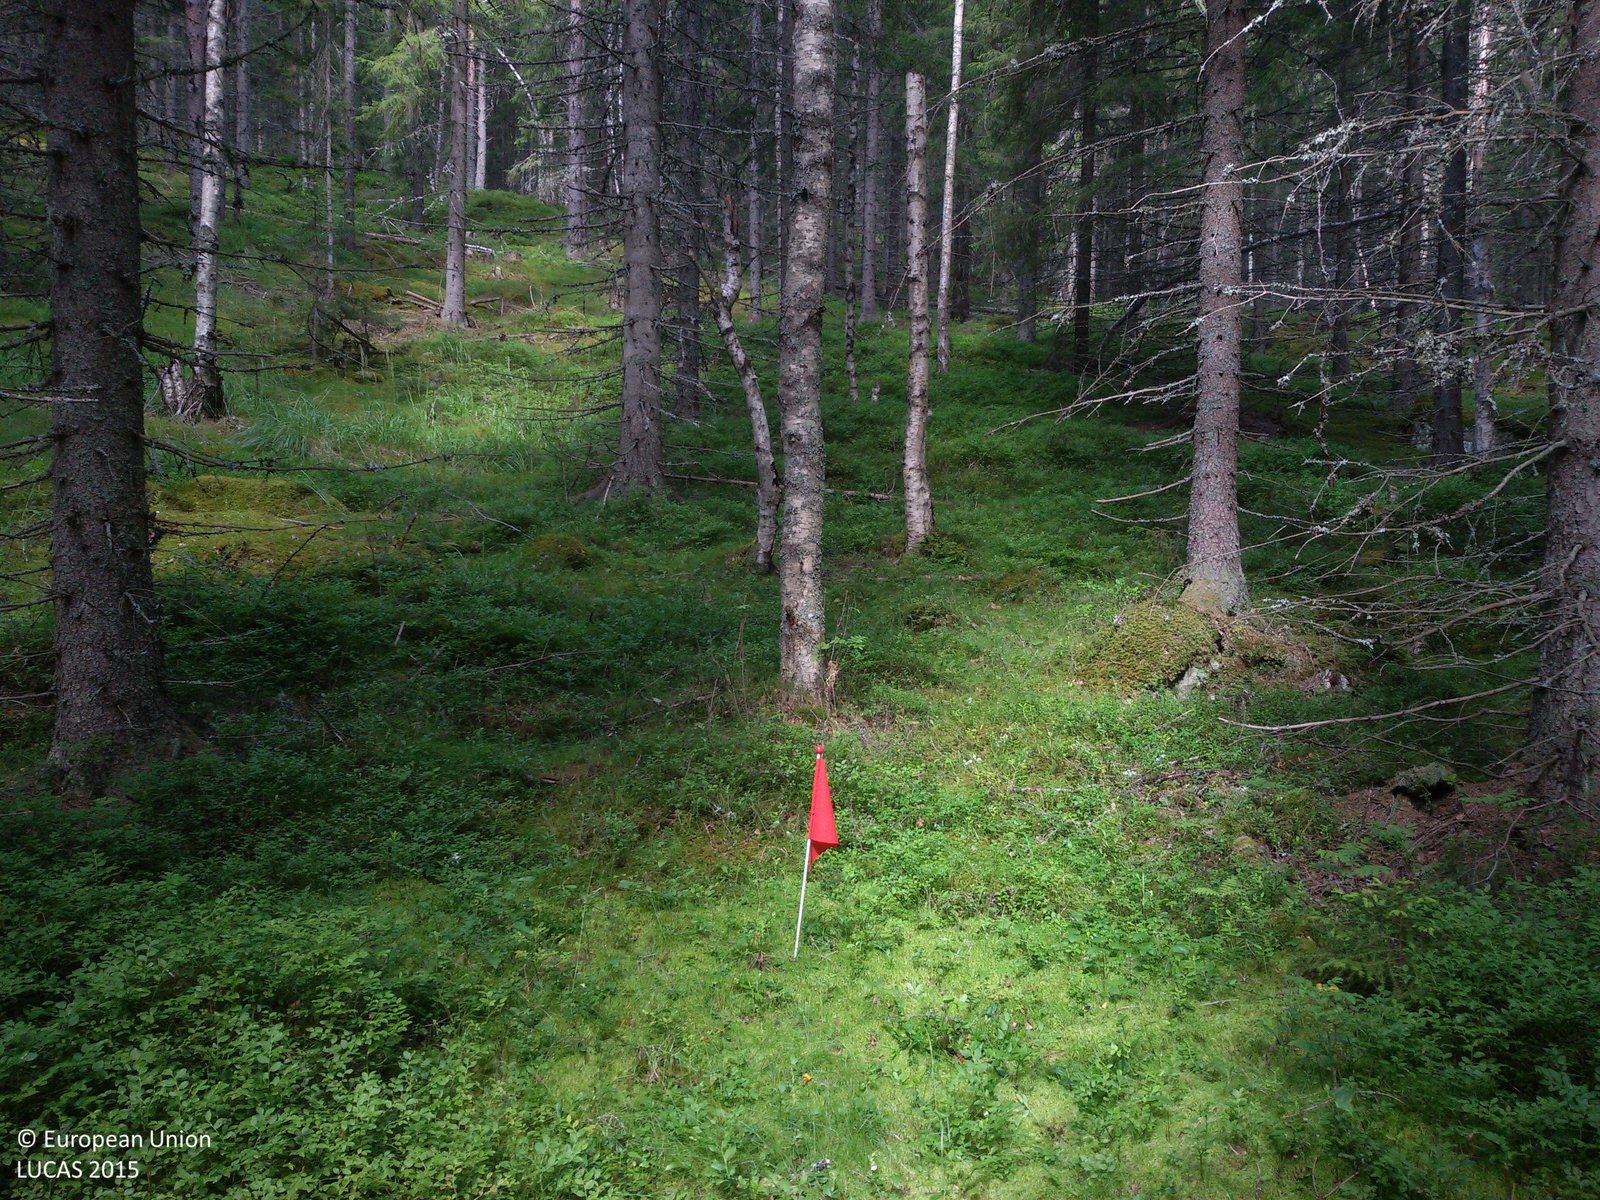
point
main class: Woodland
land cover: Spruce dominated coniferous woodland
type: boreal forest
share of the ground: > 75 %
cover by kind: coniferous forest trees 85 %, herbaceous plants 10 %, broadleaved forest trees 5 %
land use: Forestry
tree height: > 5 m
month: July
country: SE
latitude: 60.6251
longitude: 15.2325
